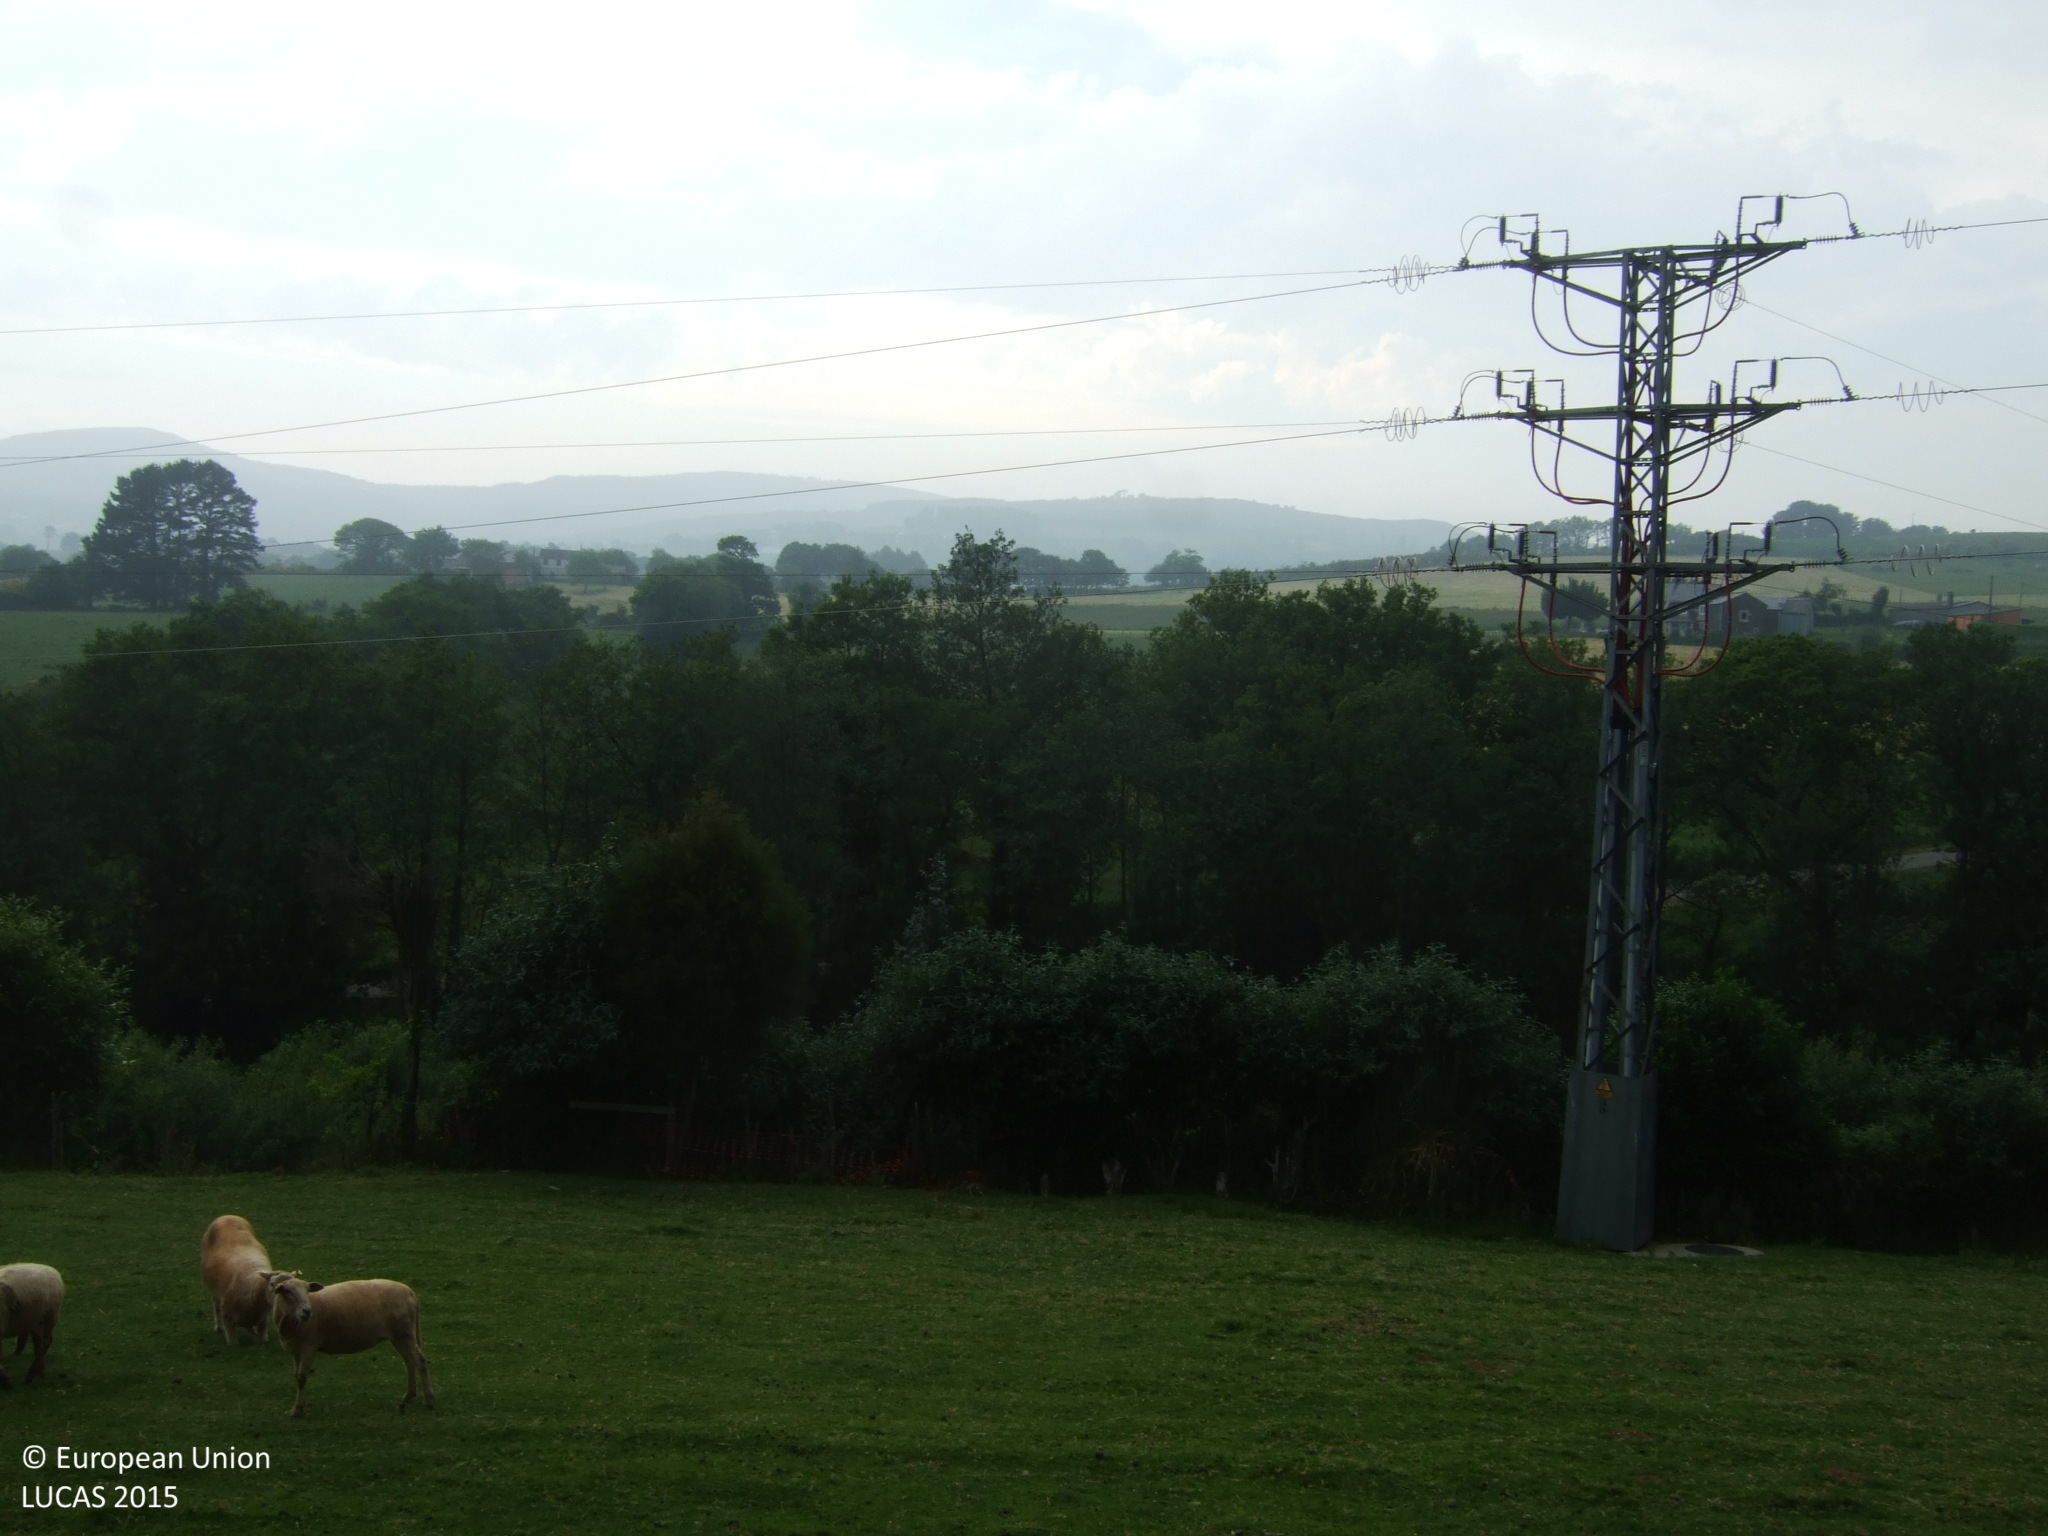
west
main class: Grassland
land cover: Grassland without tree/shrub cover
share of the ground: > 75 %
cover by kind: herbaceous plants 100 %
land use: Agriculture (excluding fallow land and kitchen gardens)
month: June
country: ES
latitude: 43.3706
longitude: -7.4678
